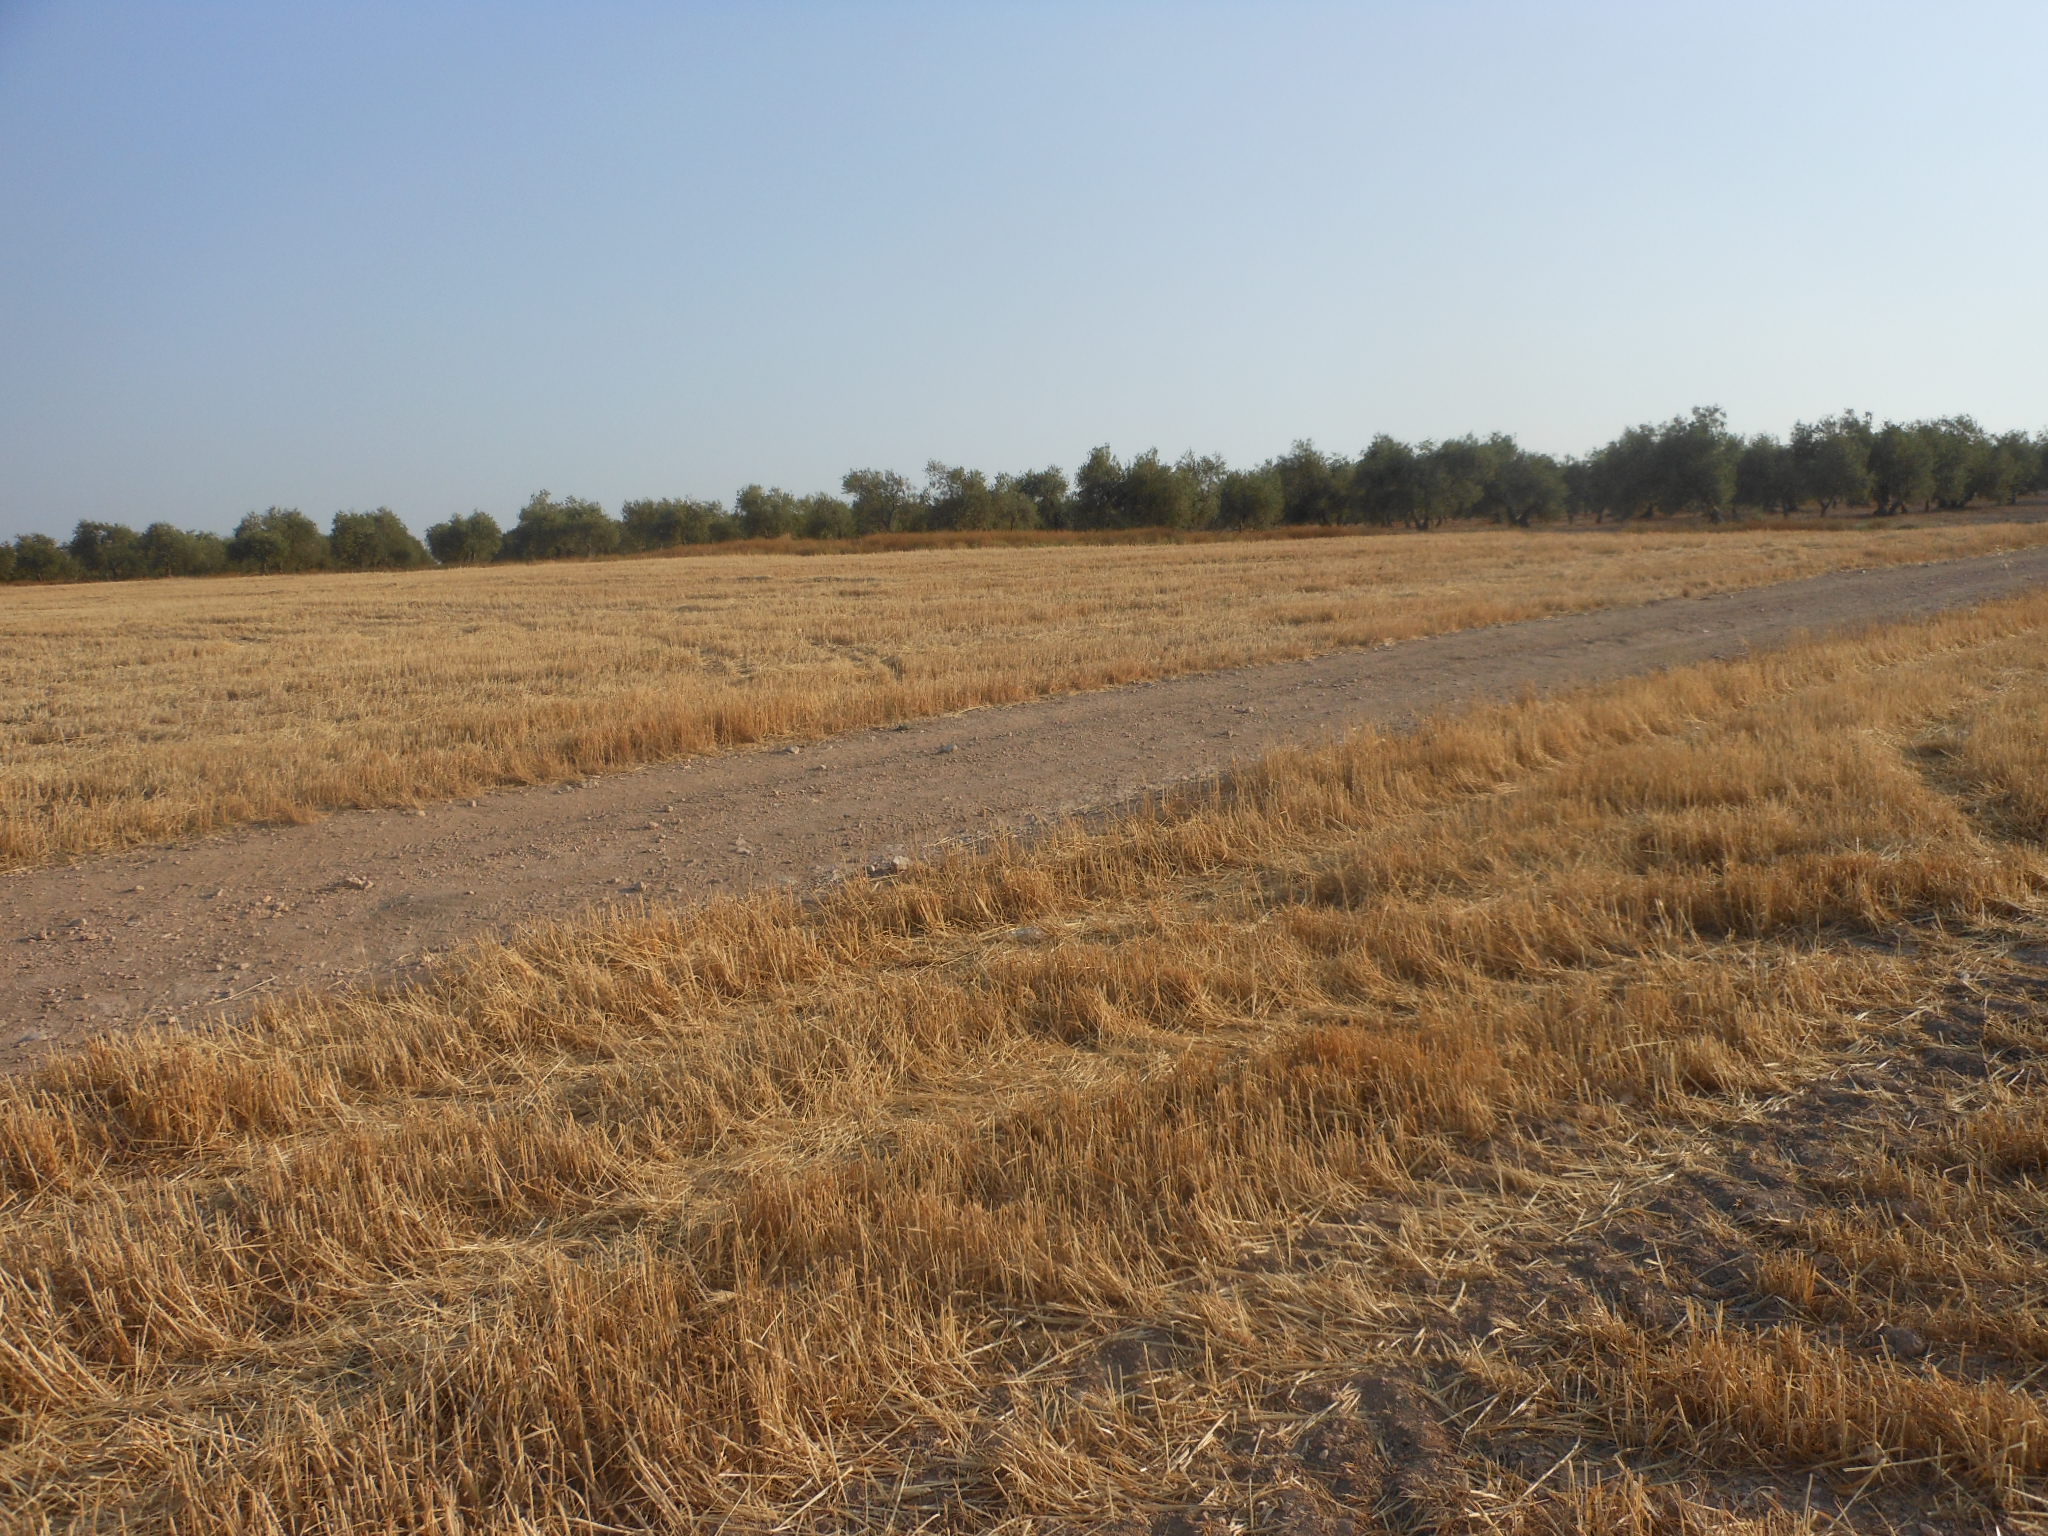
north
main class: Cropland
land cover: Durum wheat
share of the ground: < 10 %
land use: Agriculture (excluding fallow land and kitchen gardens)
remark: Harvested field
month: June
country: ES
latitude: 37.2729
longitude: -5.0859
